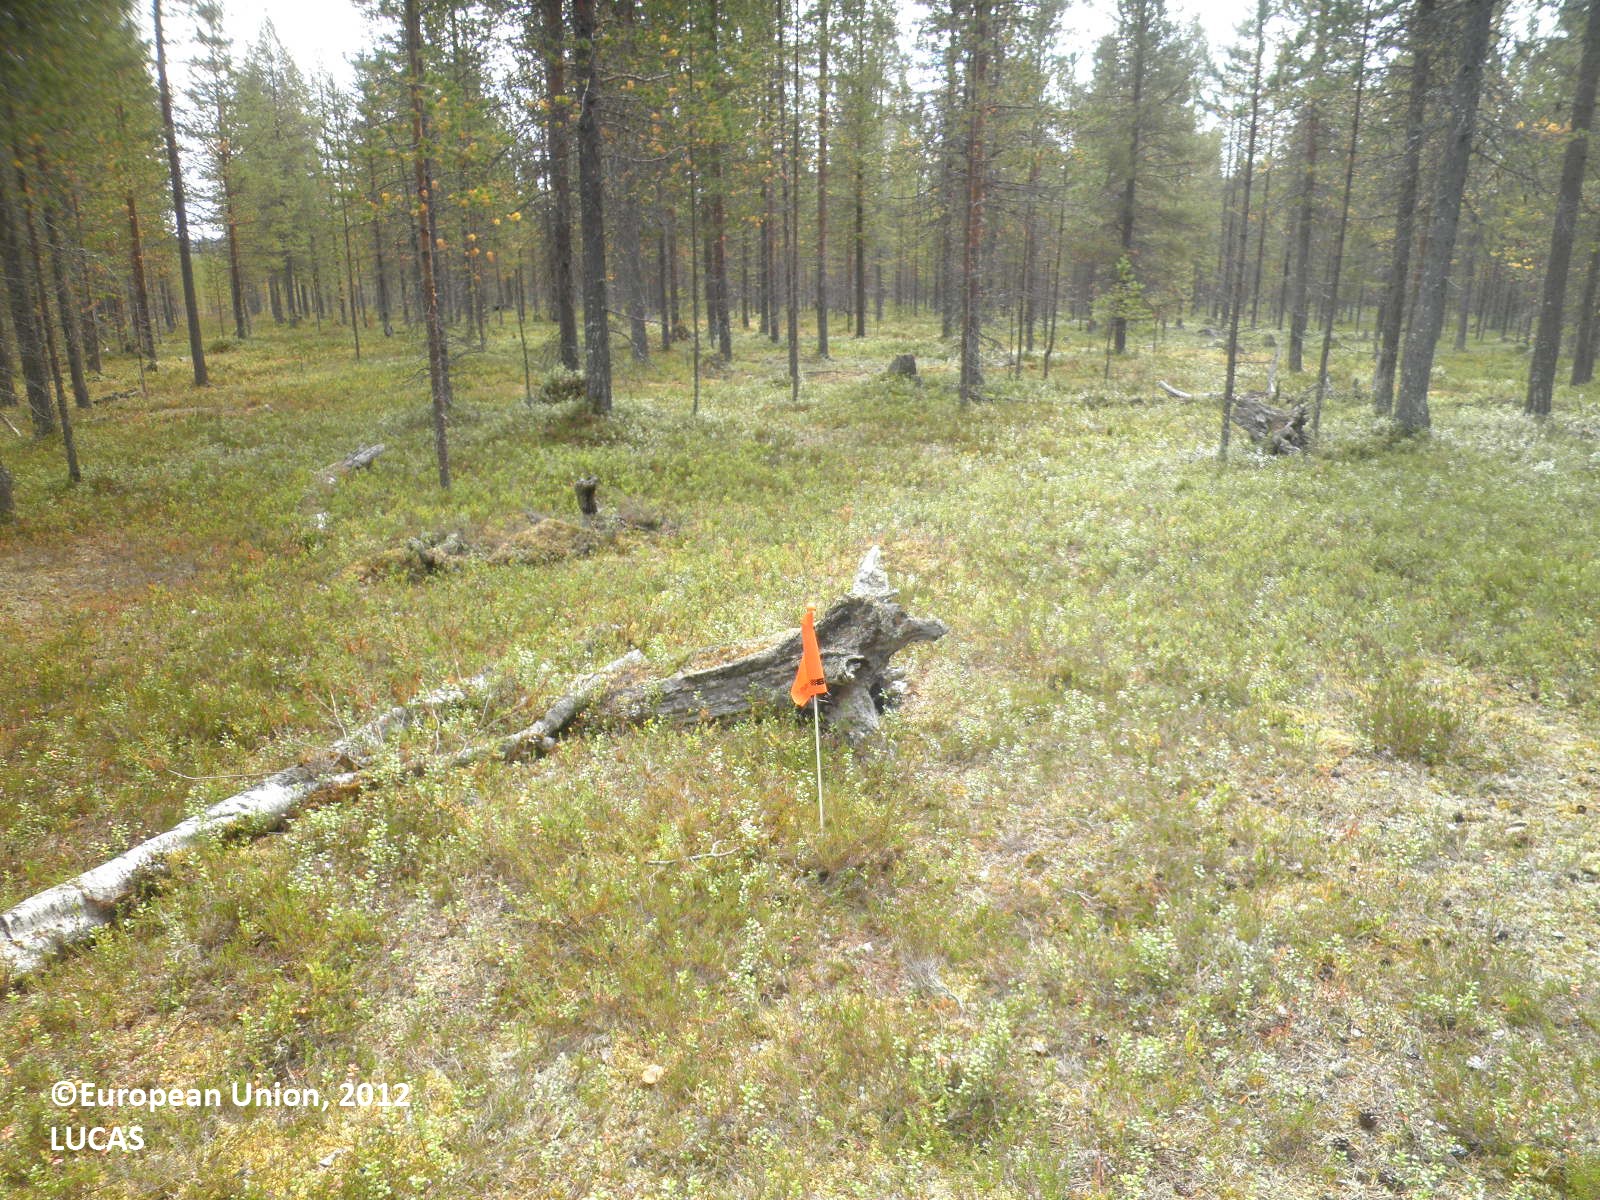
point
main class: Woodland
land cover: Pine dominated coniferous woodland
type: boreal forest
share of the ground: 50 - 75 %
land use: Forestry
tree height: > 5 m
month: August
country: FI
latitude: 67.7451
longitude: 28.9006
